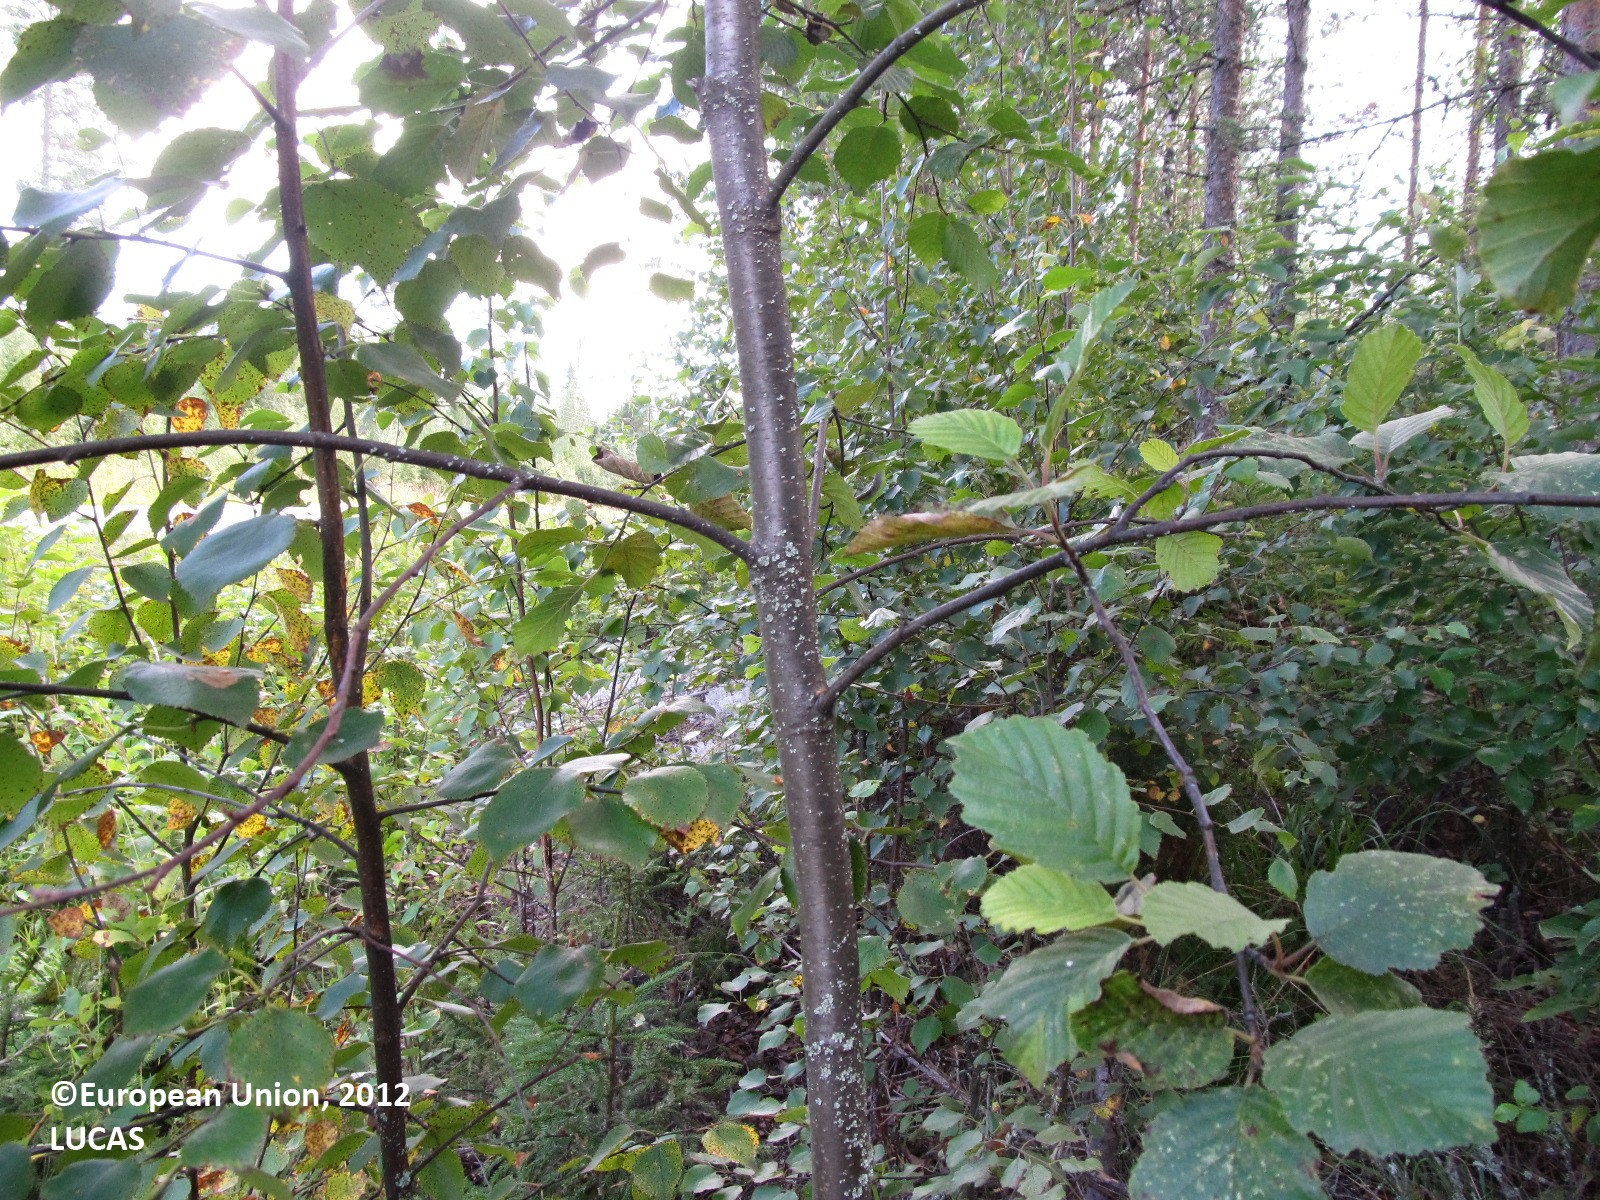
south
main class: Woodland
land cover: Pine dominated mixed woodland
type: boreal forest
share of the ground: 50 - 75 %
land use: Forestry
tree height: > 5 m
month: August
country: FI
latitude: 62.3108
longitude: 28.3103
